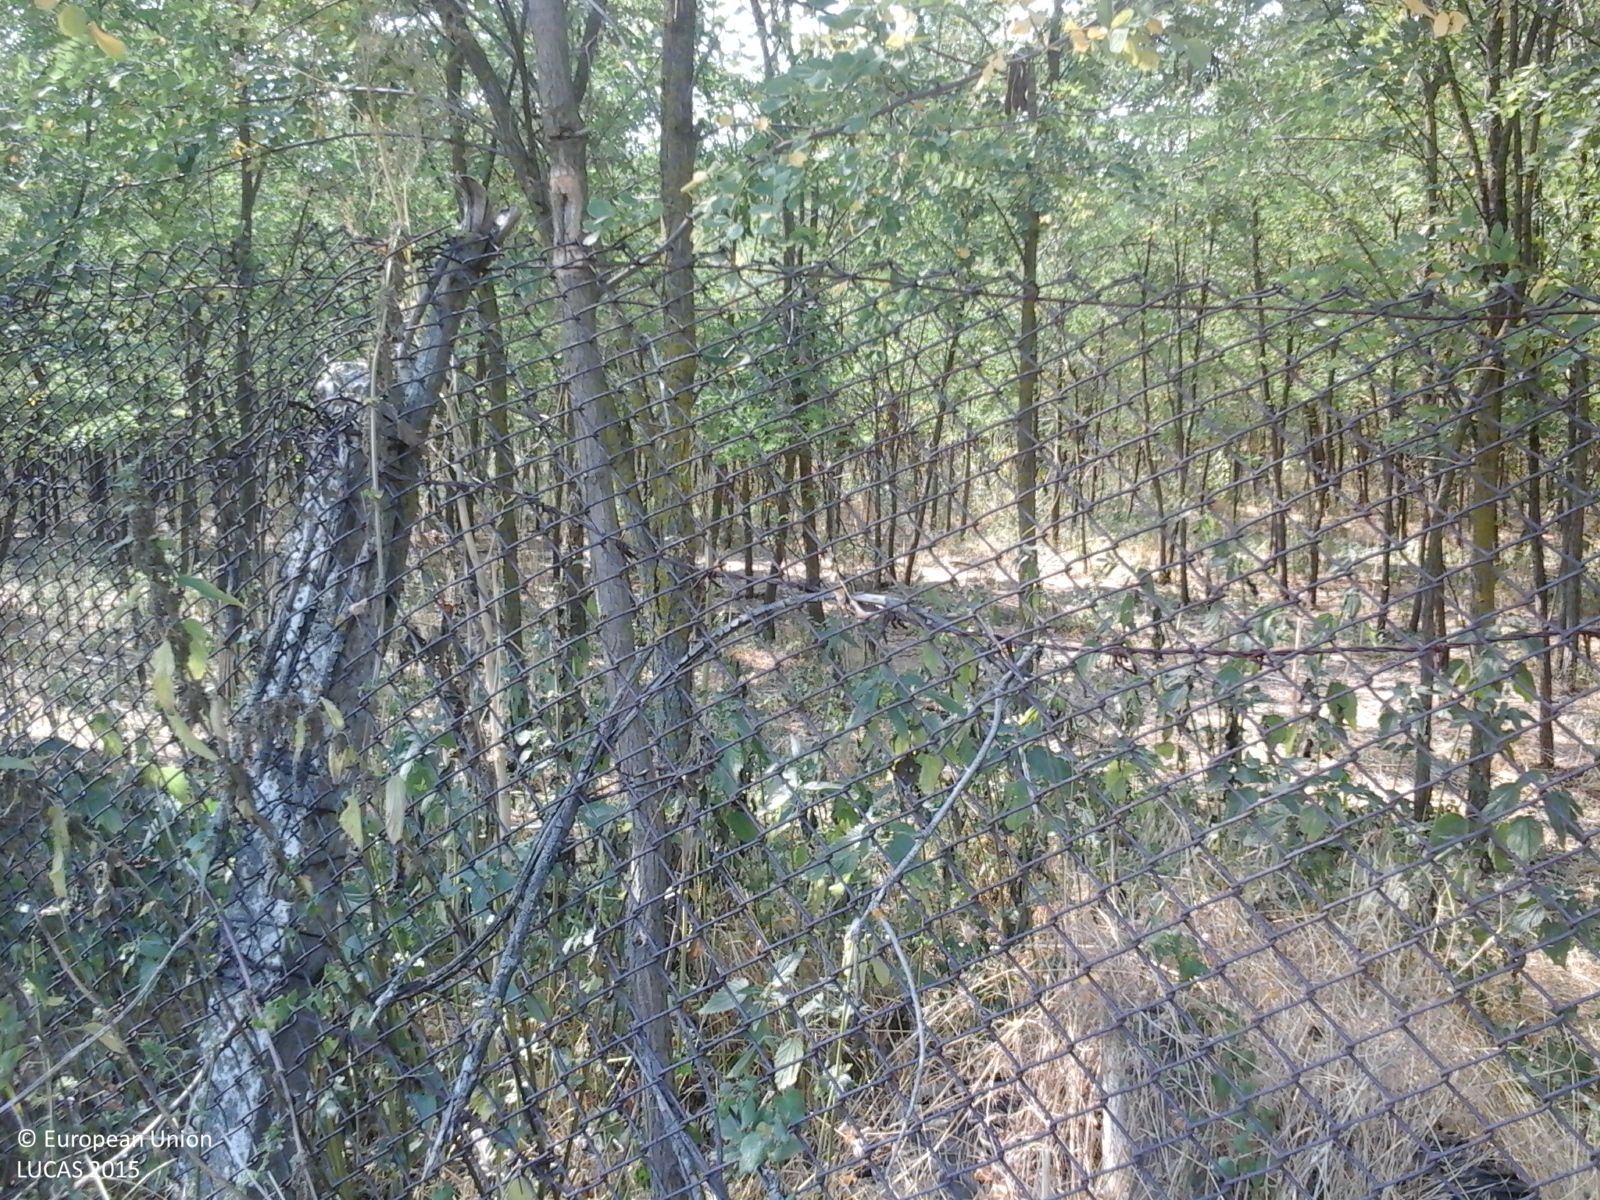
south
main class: Woodland
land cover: Broadleaved woodland
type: exotic forest
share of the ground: > 75 %
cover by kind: broadleaved forest trees 100 %
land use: Forestry
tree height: > 5 m
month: July
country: RO
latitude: 45.5987
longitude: 27.5794
